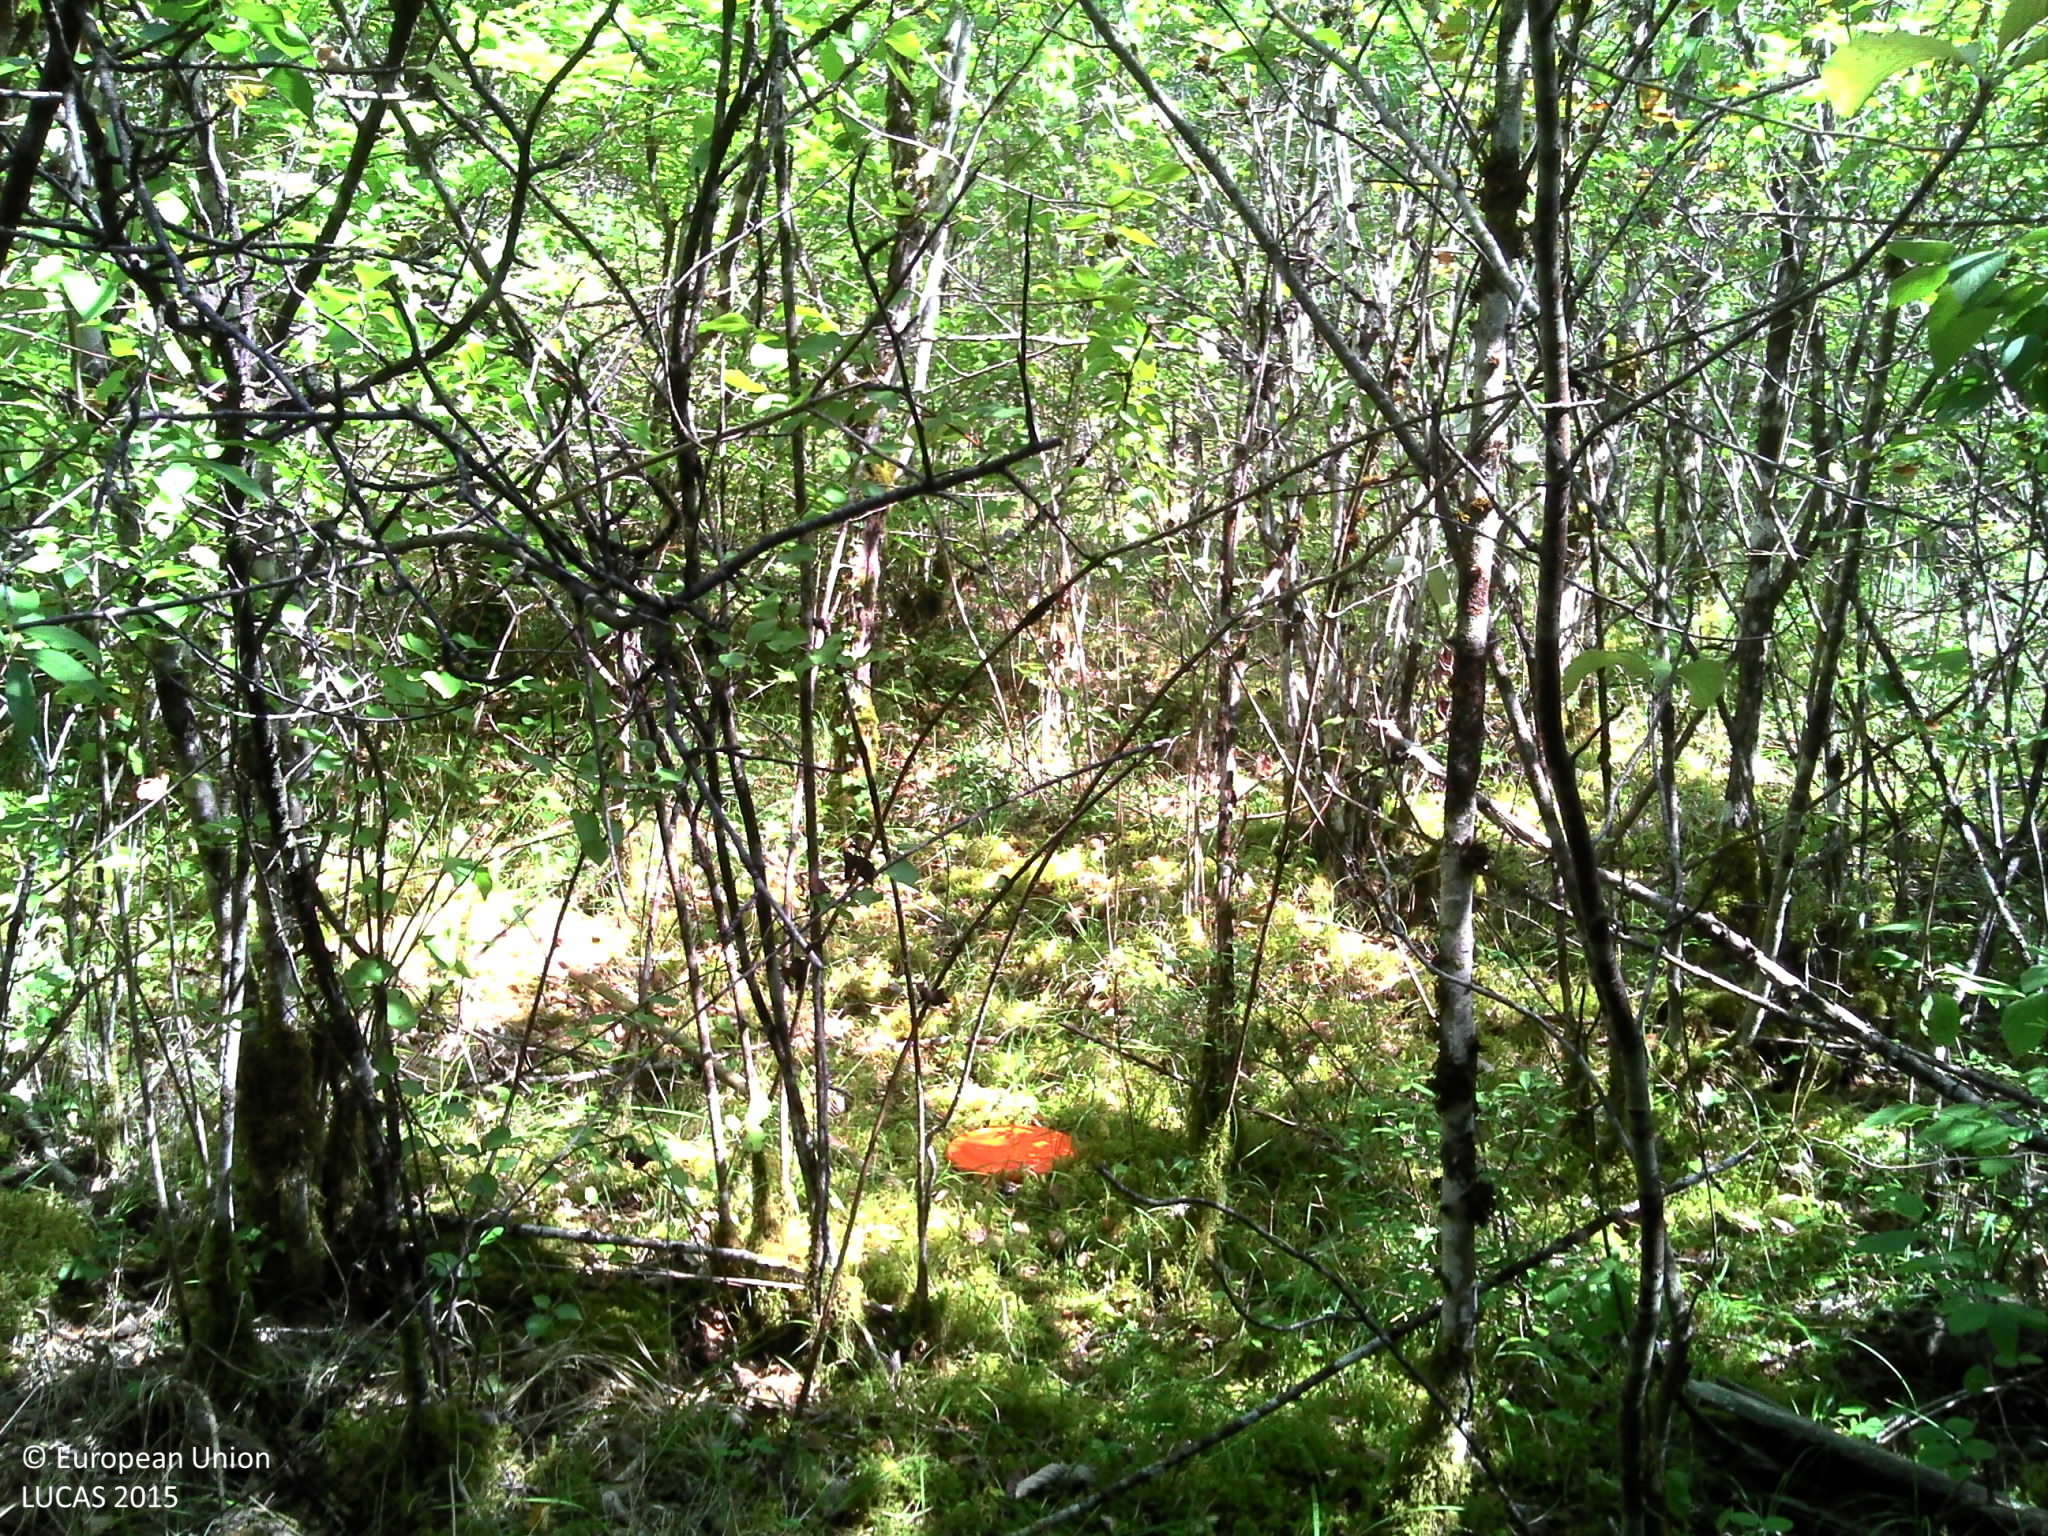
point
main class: Woodland
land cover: Pine dominated mixed woodland
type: hemiboreal forest and nemoral coniferous forest and mixed broadleaved-coniferous forest
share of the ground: > 75 %
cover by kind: broadleaved forest trees 60 %, coniferous forest trees 25 %, herbaceous plants 10 %, lichens and mosses 5 %
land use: Forestry
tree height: > 5 m
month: August
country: FR
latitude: 47.7278
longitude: 4.9197
